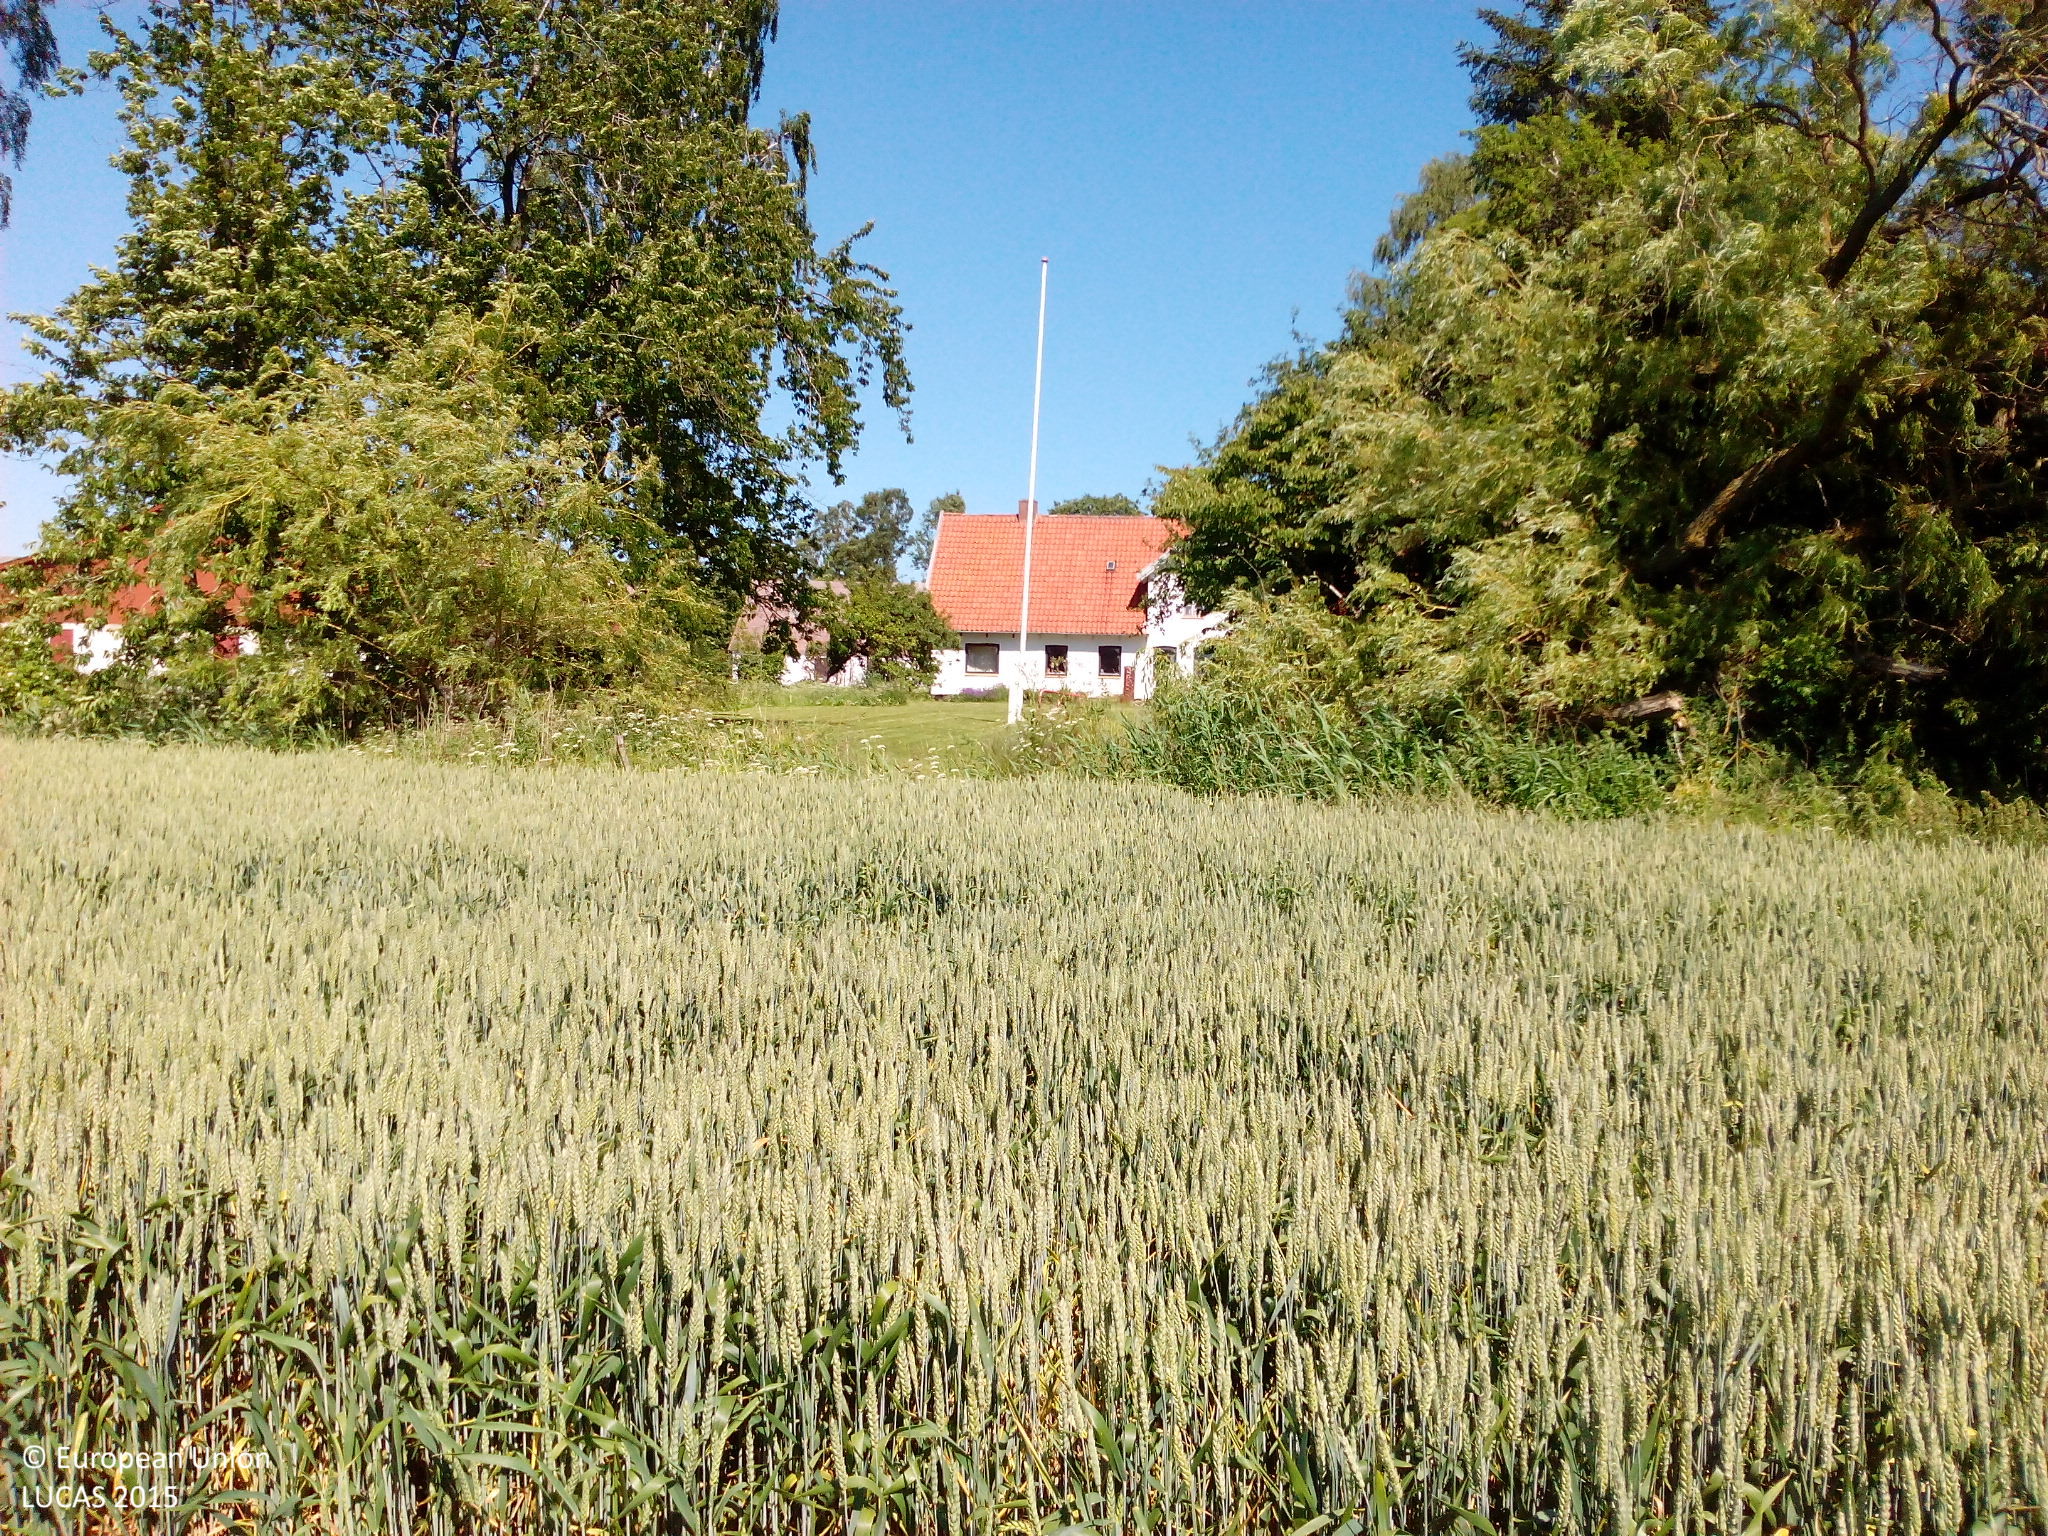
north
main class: Cropland
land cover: Common wheat
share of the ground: > 75 %
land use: Agriculture (excluding fallow land and kitchen gardens)
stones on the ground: 10 - 25 %
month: July
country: DK
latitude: 56.3838
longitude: 10.6632
